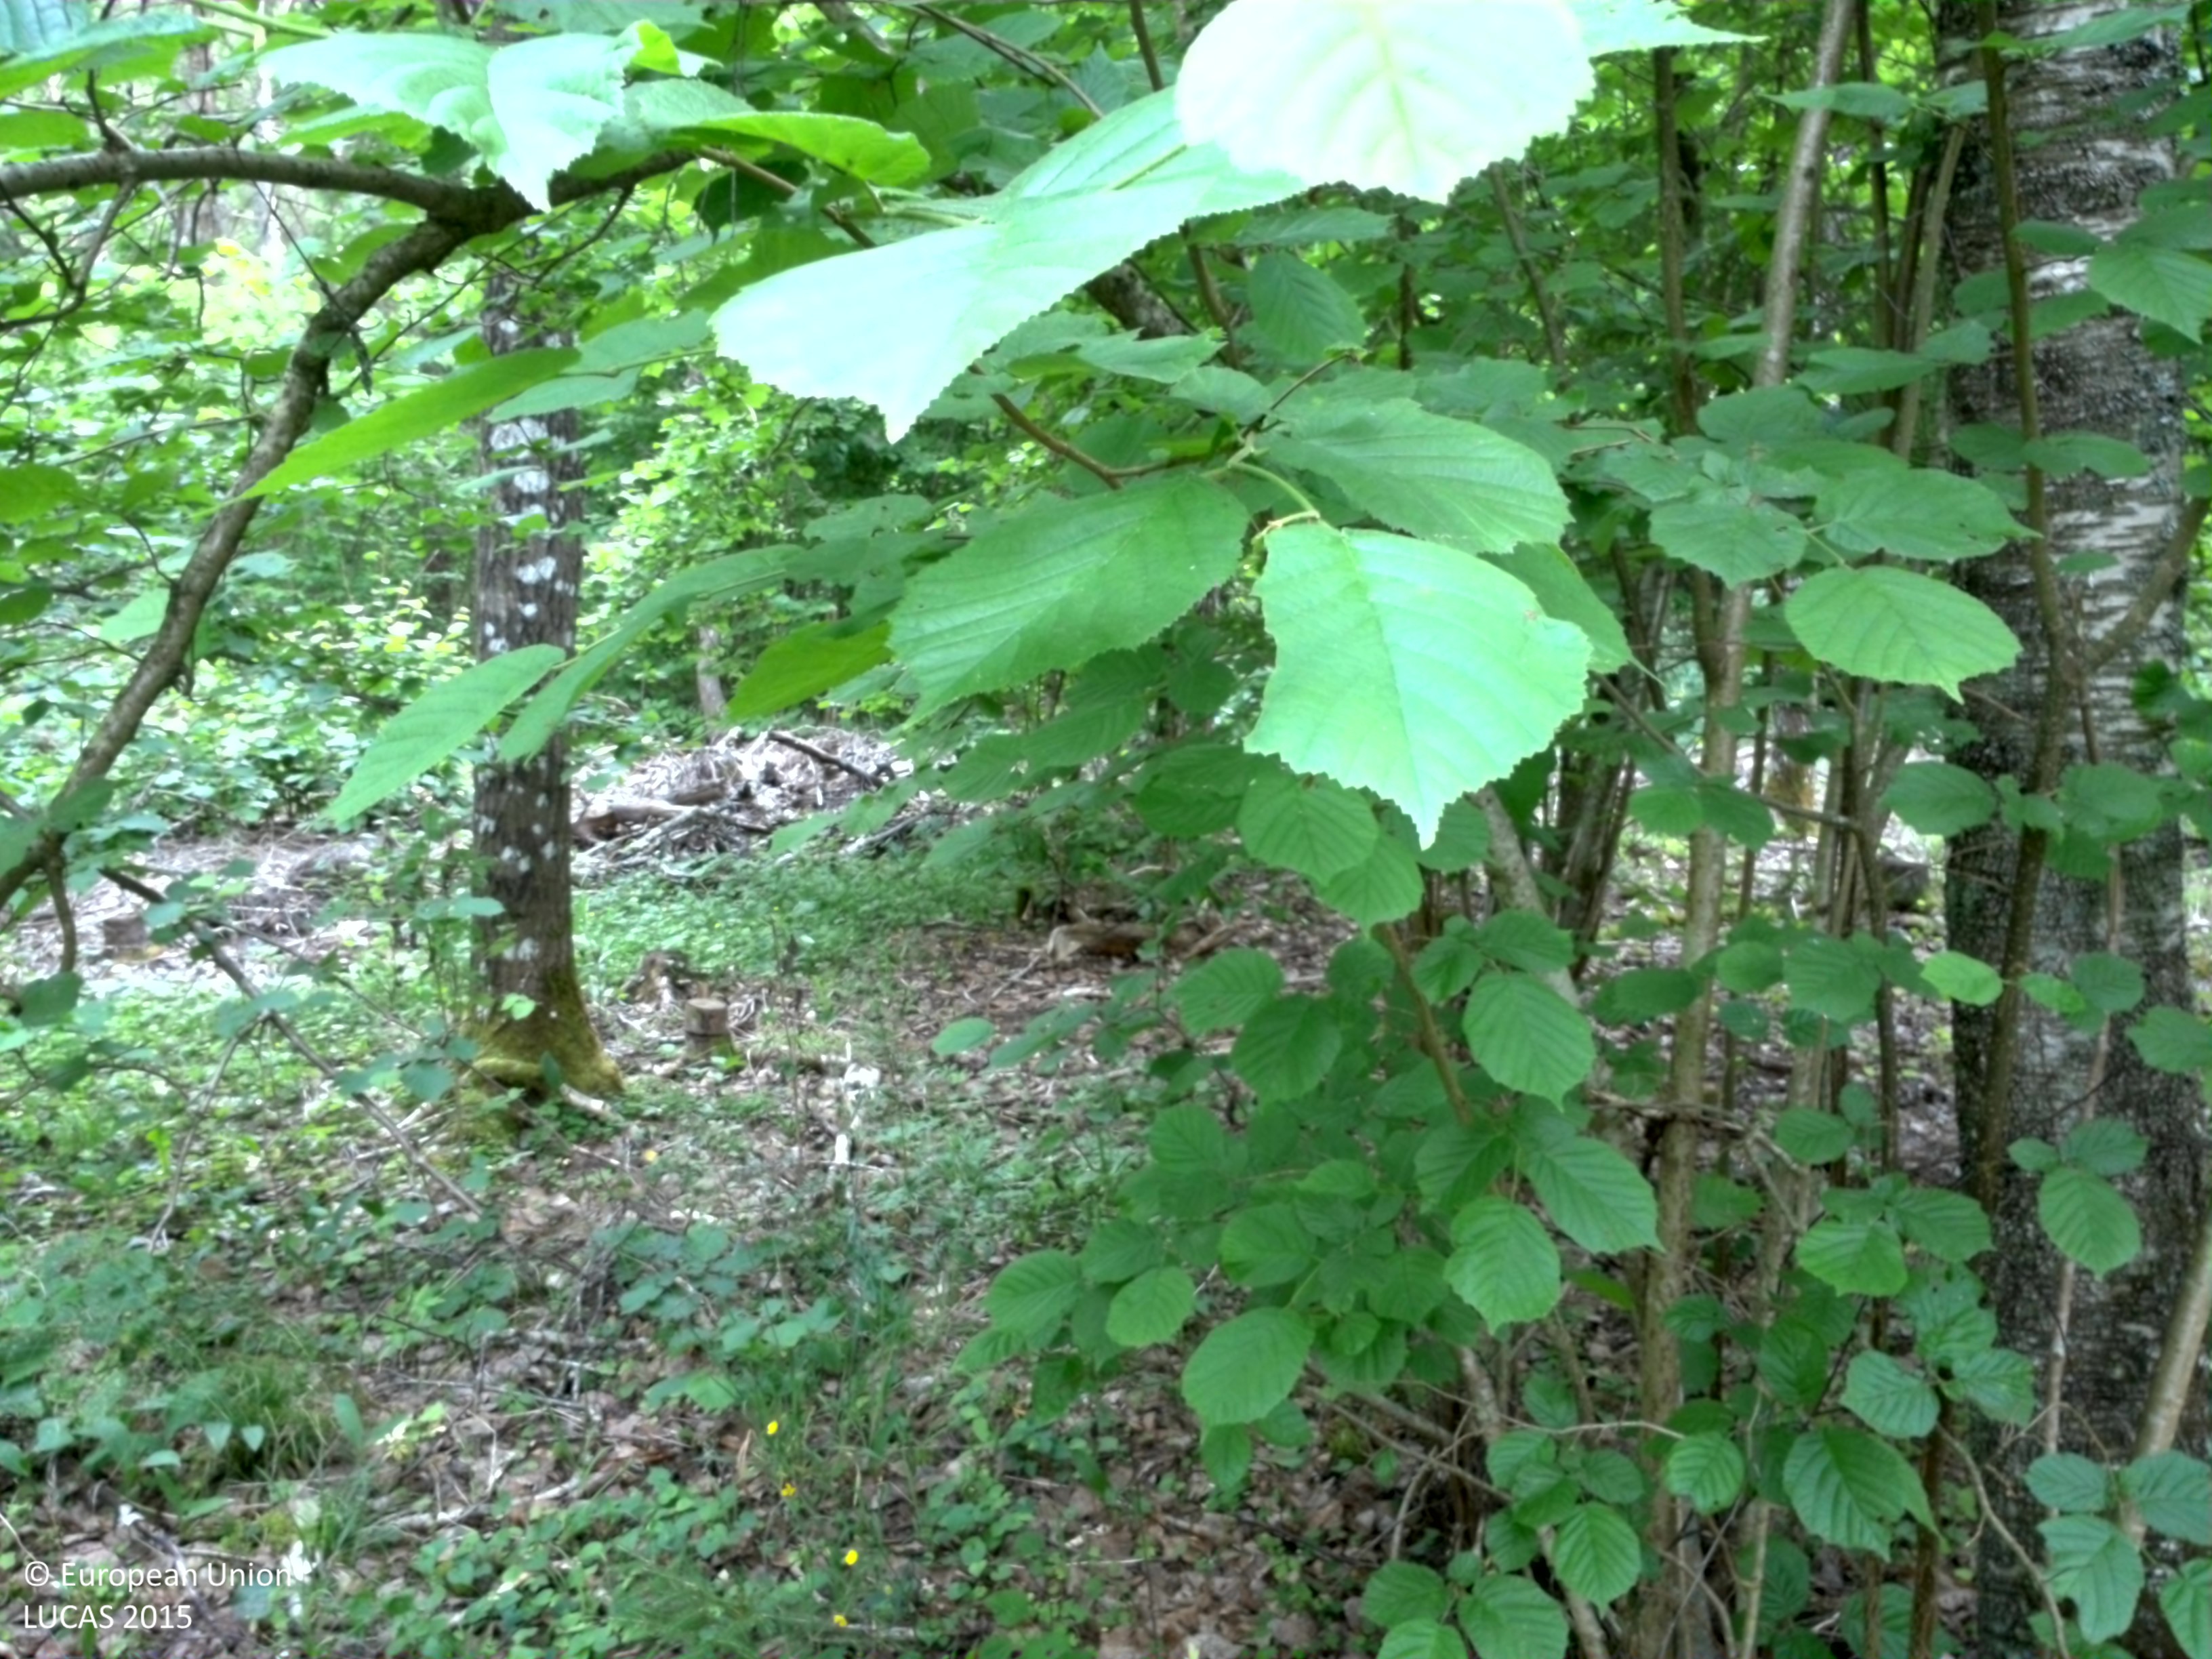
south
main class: Woodland
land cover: Broadleaved woodland
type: hemiboreal forest and nemoral coniferous forest and mixed broadleaved-coniferous forest
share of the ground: > 75 %
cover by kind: broadleaved forest trees 70 %, herbaceous plants 25 %, coniferous forest trees 5 %
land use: Forestry
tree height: > 5 m
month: July
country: SE
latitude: 59.7983
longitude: 17.5329
